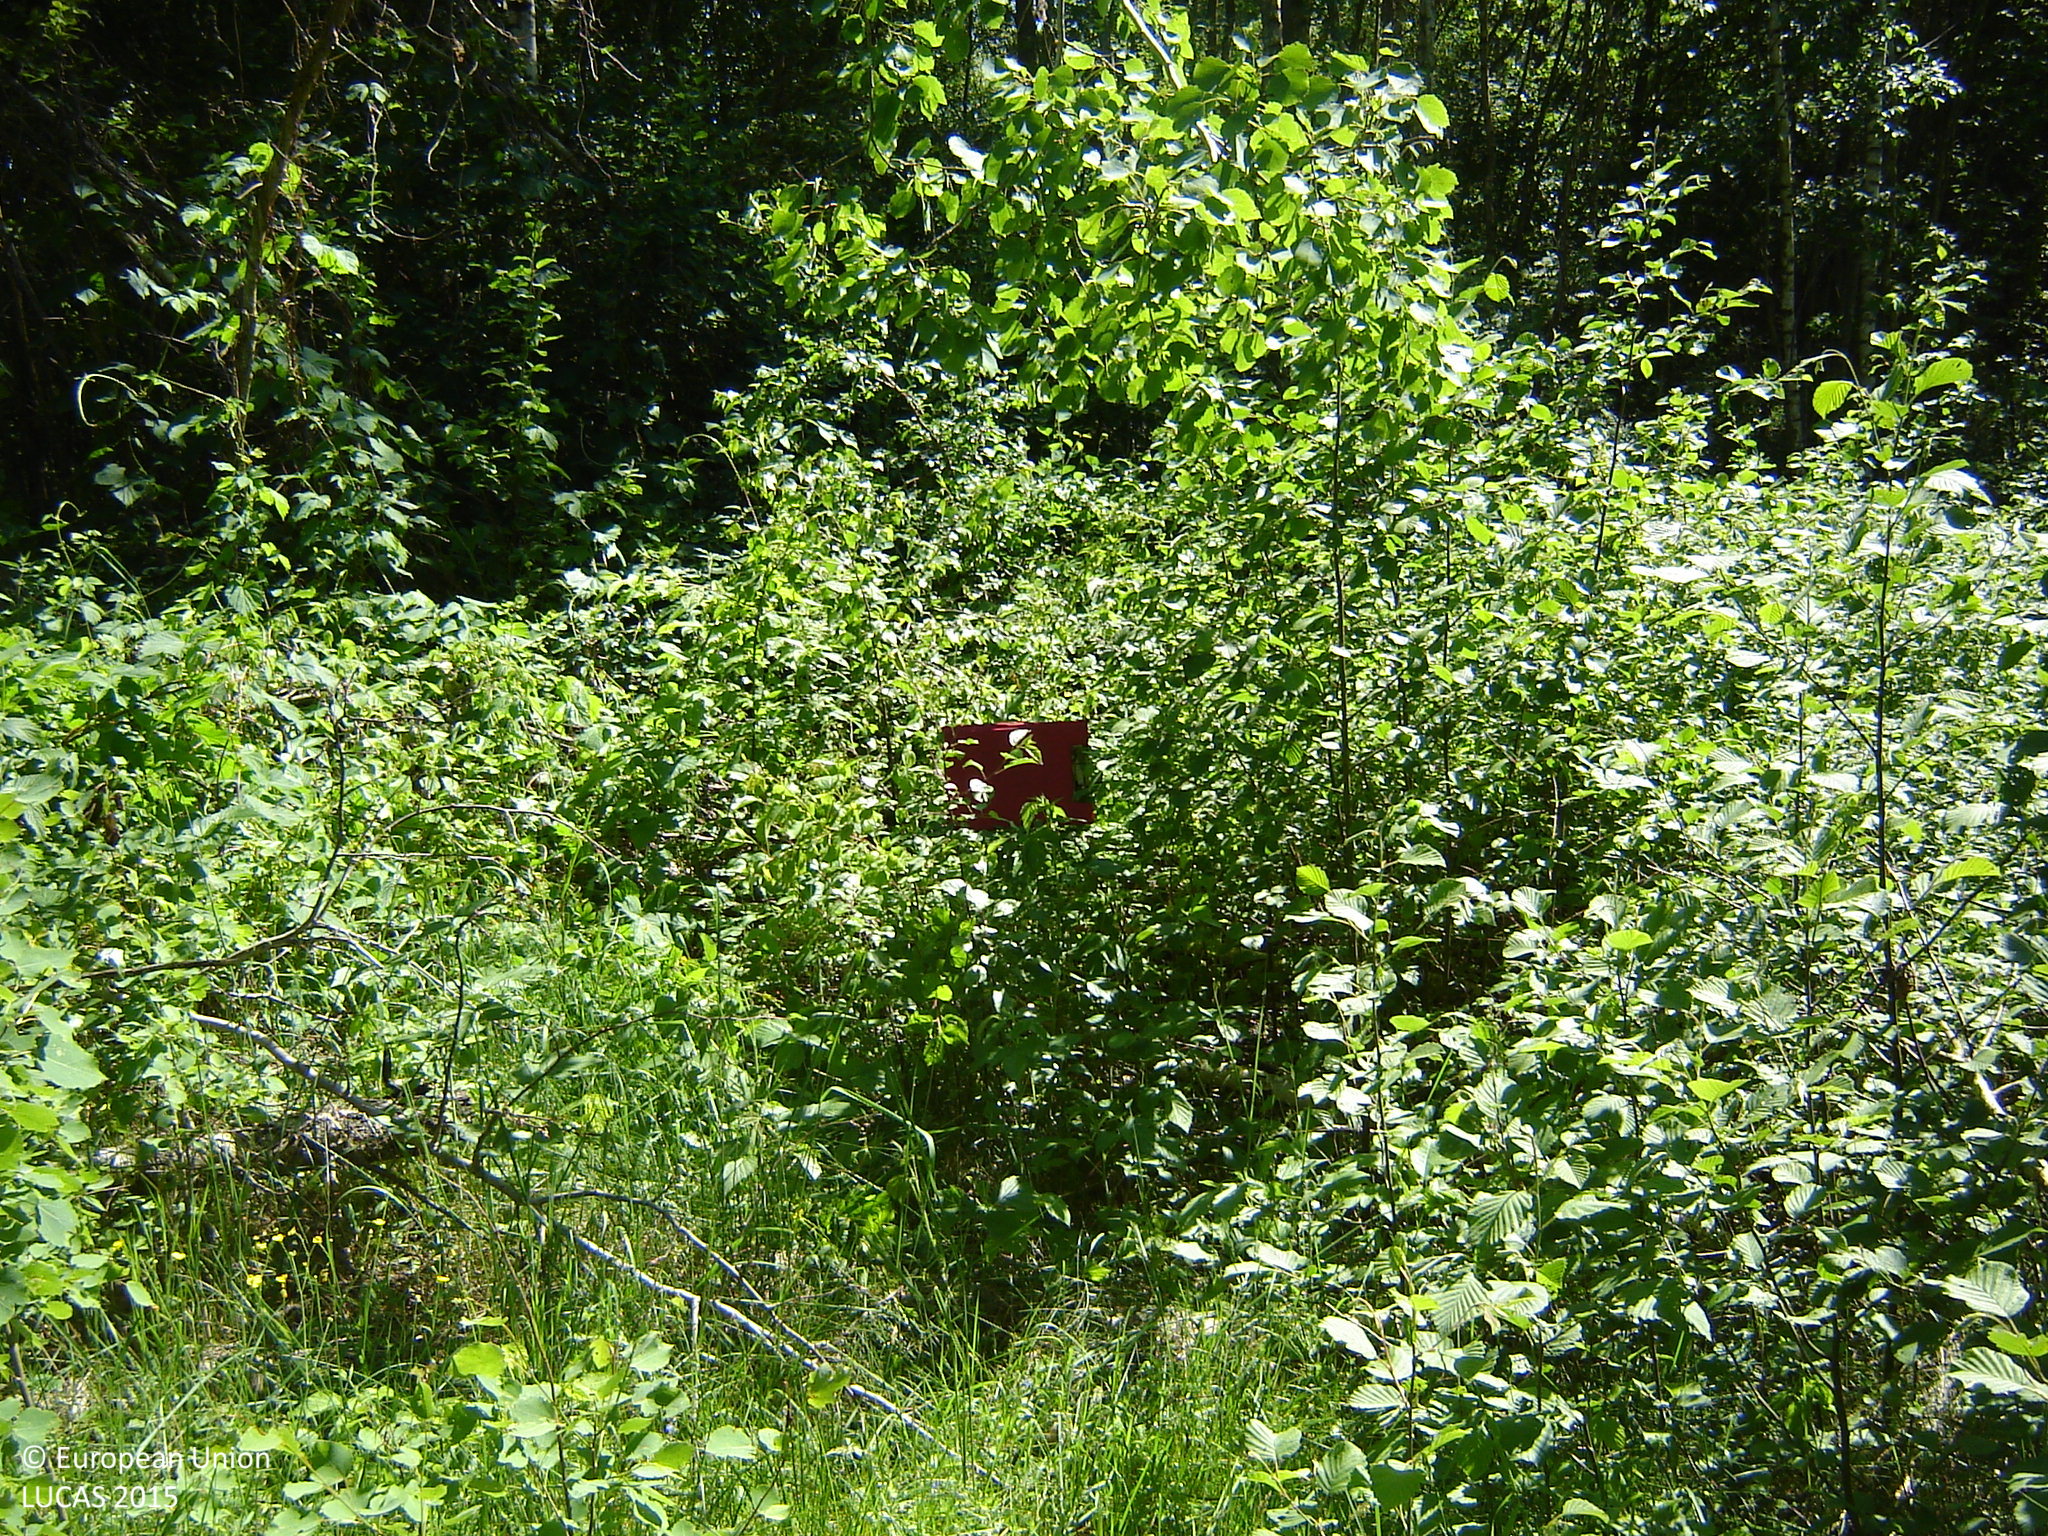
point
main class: Artificial land
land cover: Other artificial areas
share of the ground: > 75 %
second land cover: Spontaneously vegetated surfaces
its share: > 75 %
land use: Electricity, gas and thermal power distribution
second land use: Forestry
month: June
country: LT
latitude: 55.5656
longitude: 25.0664
